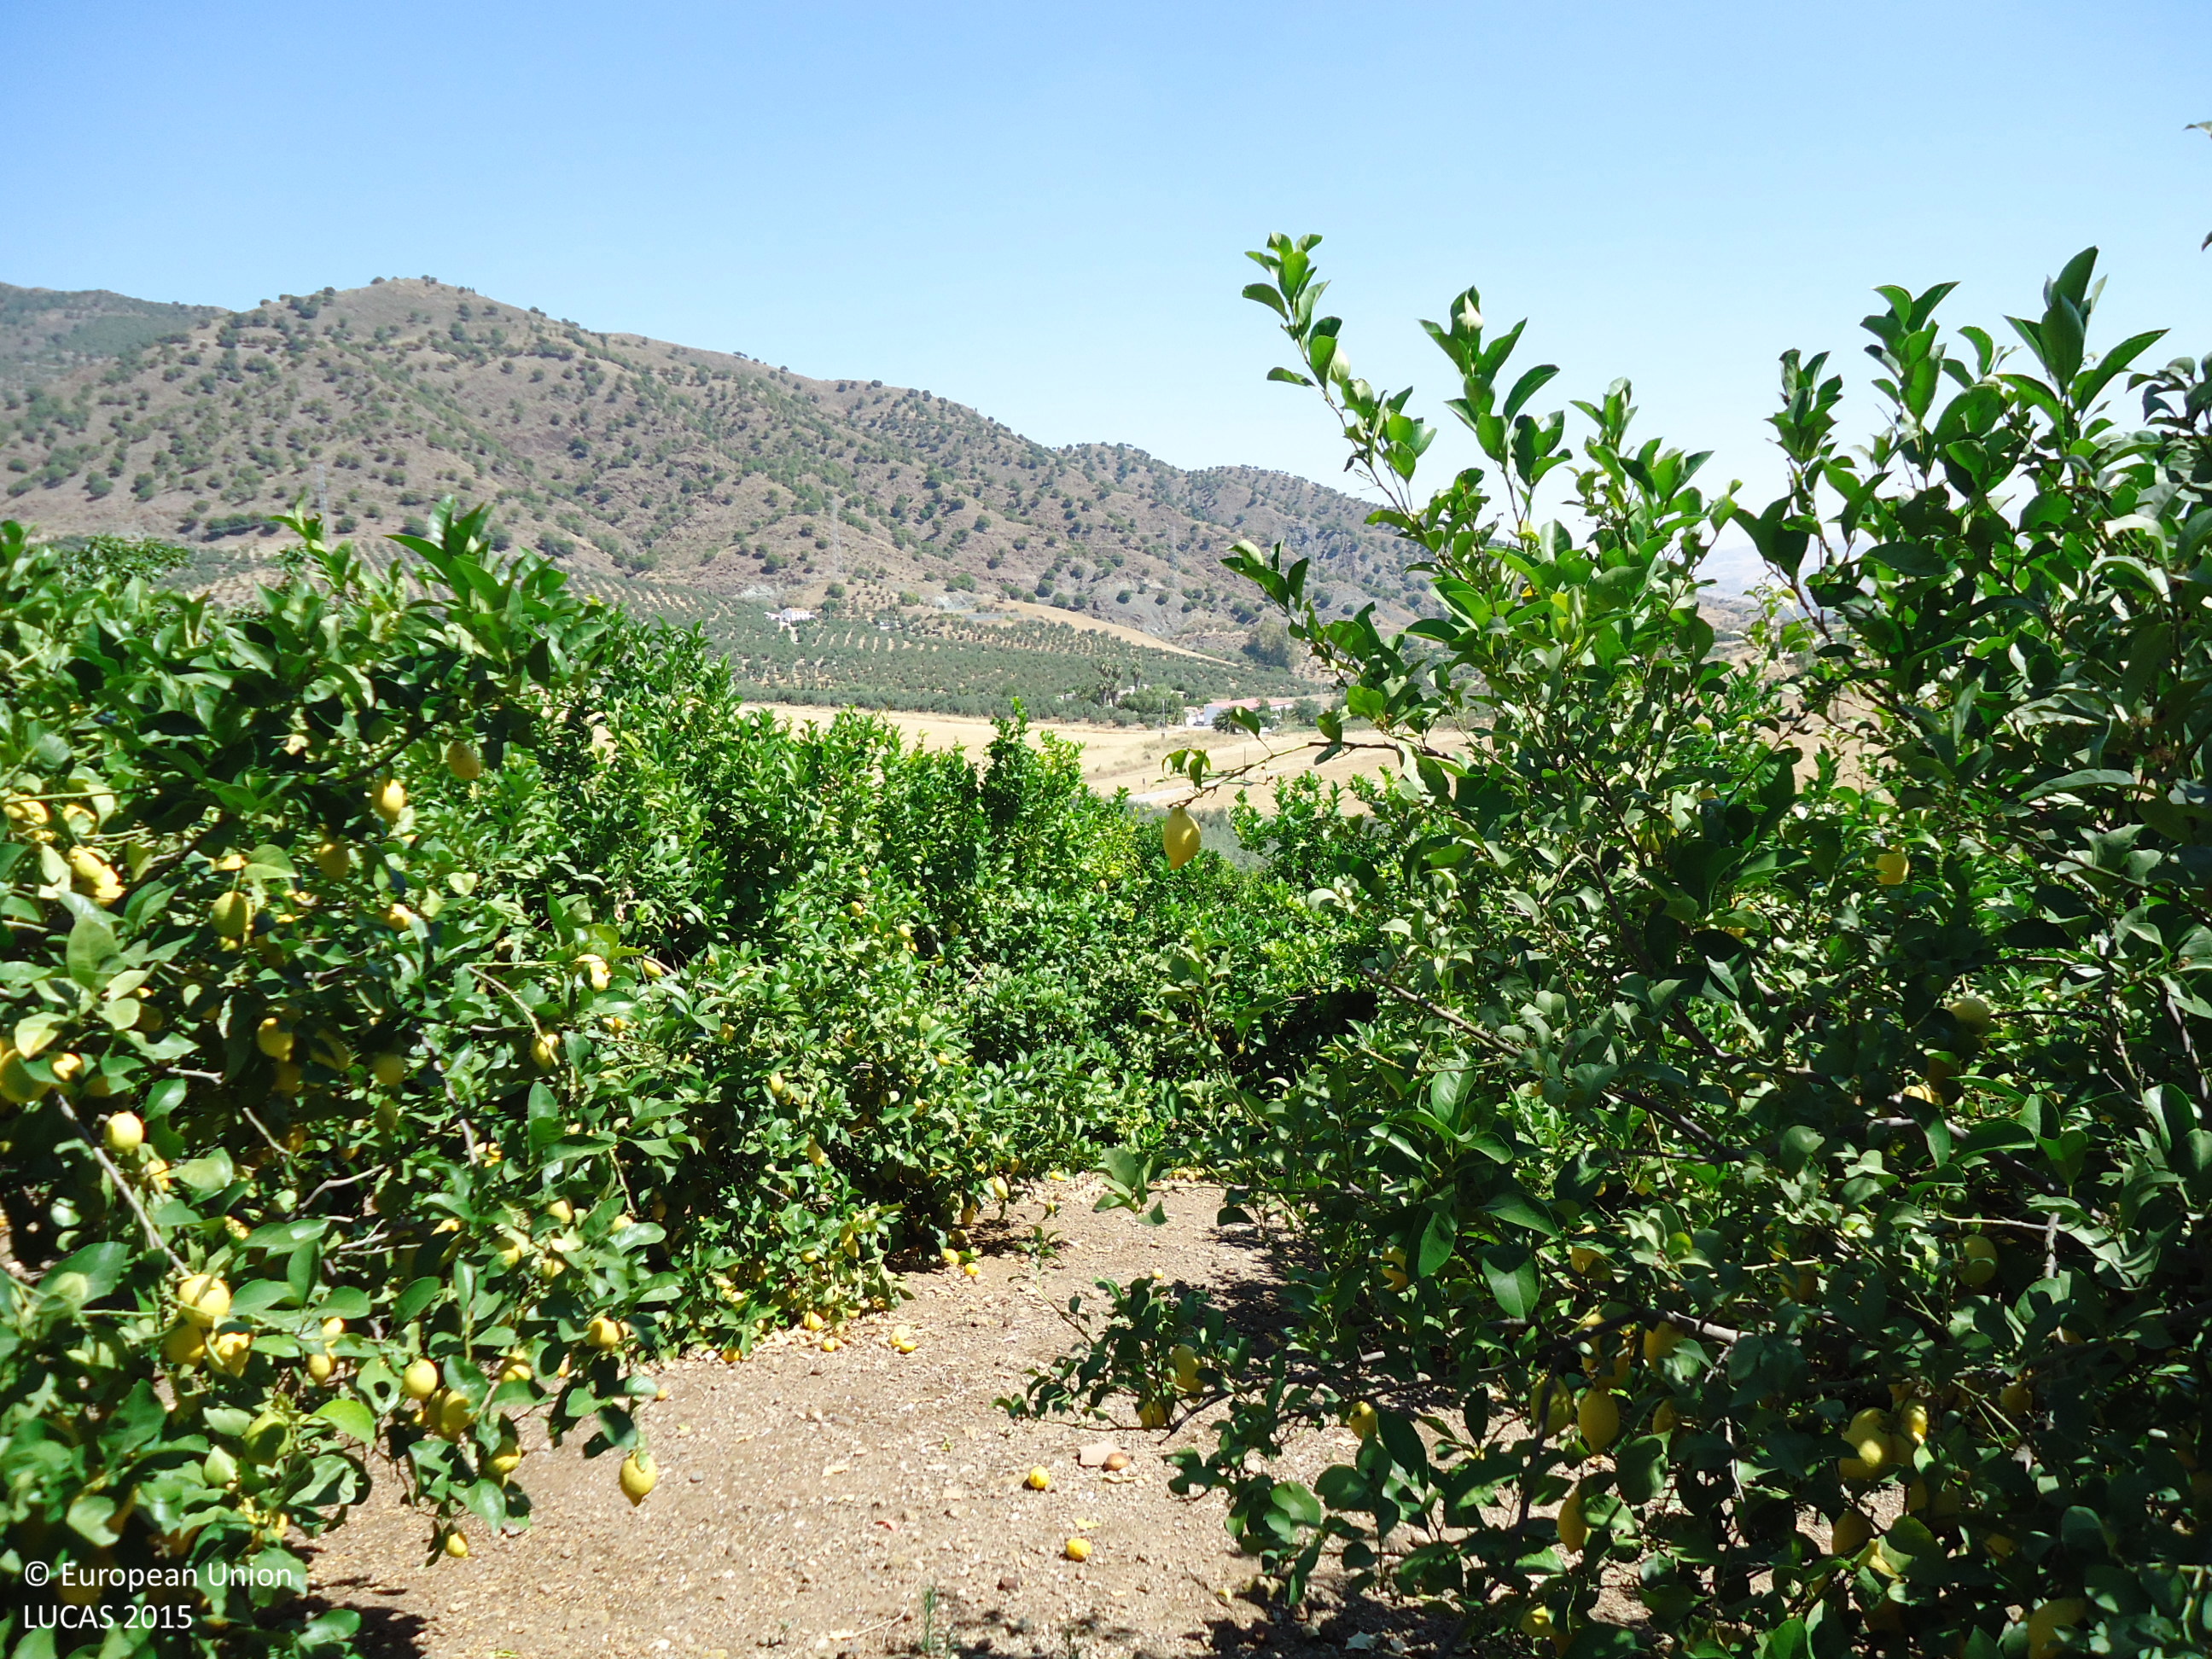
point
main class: Cropland
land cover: Other citrus fruit
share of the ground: > 75 %
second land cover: Other bare soil
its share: > 75 %
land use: Agriculture (excluding fallow land and kitchen gardens)
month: June
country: ES
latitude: 36.8313
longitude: -4.7397
